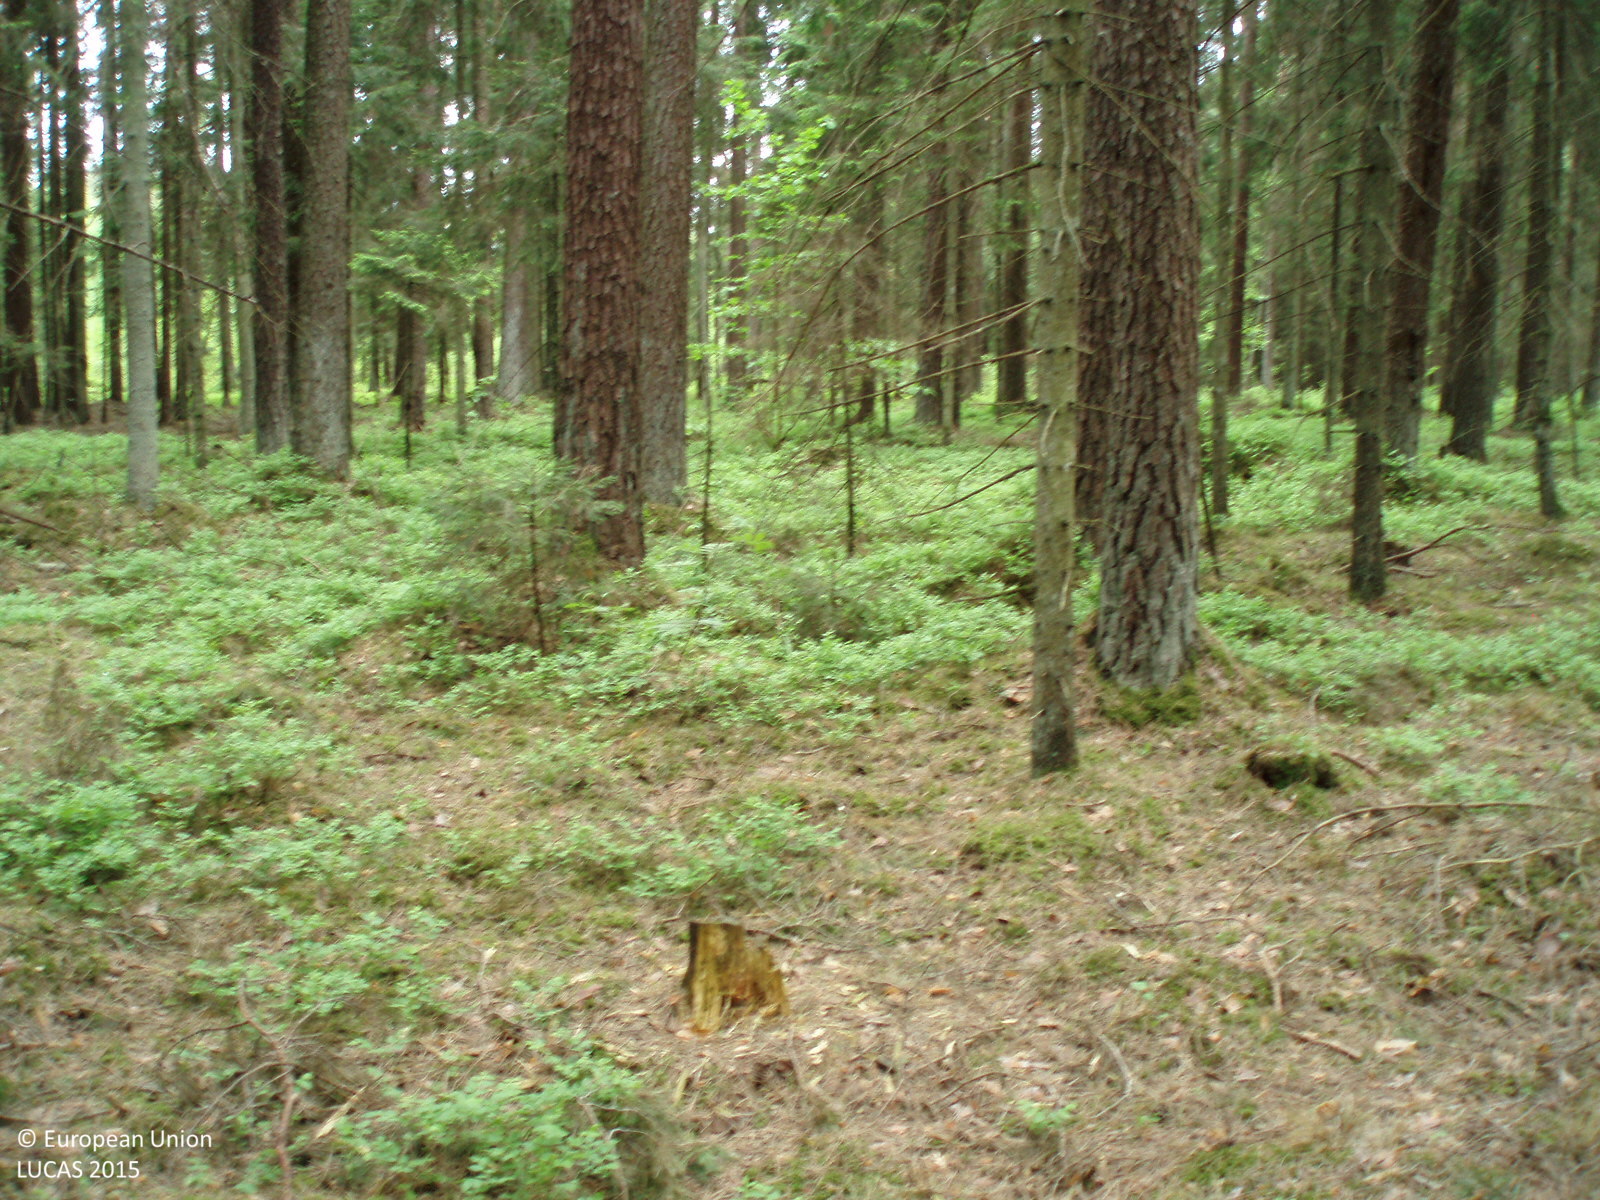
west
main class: Woodland
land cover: Pine dominated coniferous woodland
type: hemiboreal forest and nemoral coniferous forest and mixed broadleaved-coniferous forest
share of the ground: > 75 %
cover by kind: coniferous forest trees 95 %, herbaceous plants 5 %
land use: Forestry
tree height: > 5 m
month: May
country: LT
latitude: 56.2092
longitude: 22.5211
